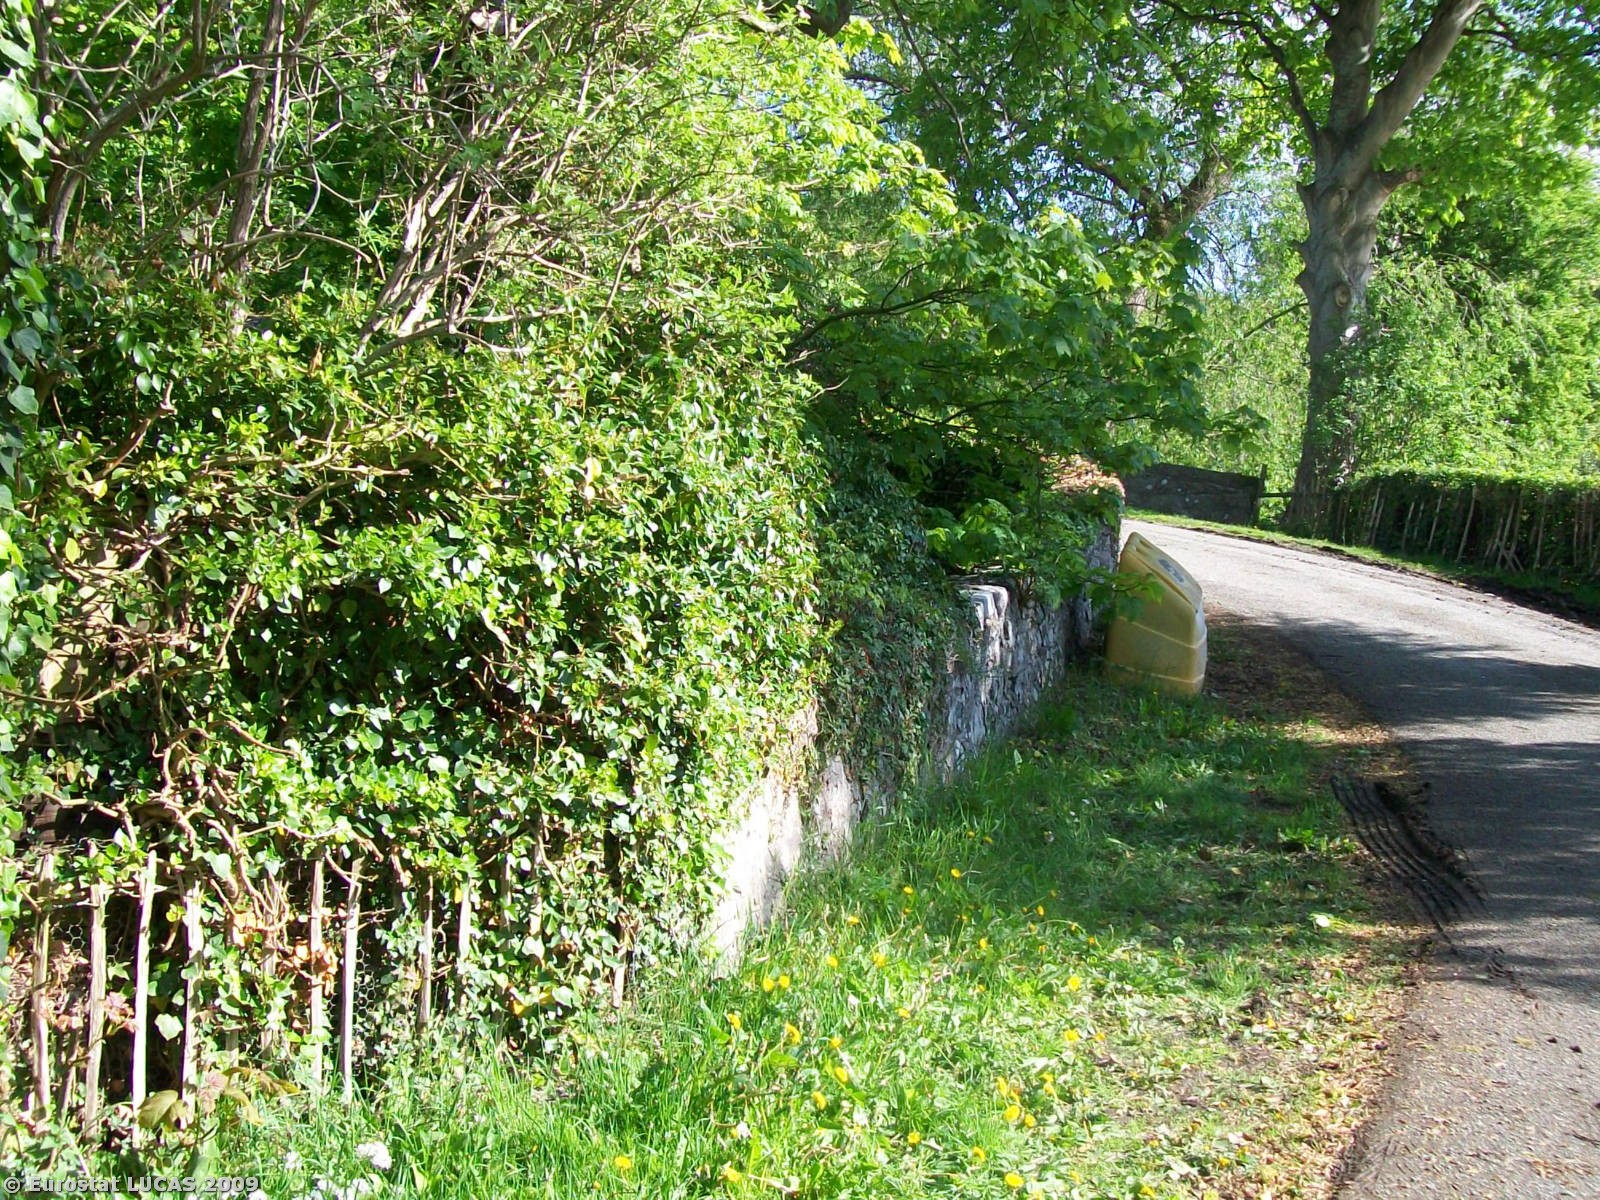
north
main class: Water areas
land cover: Inland running water
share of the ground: 10 - 25 %
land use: Unused
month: May
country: GB
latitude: 53.2372
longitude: -3.5546
